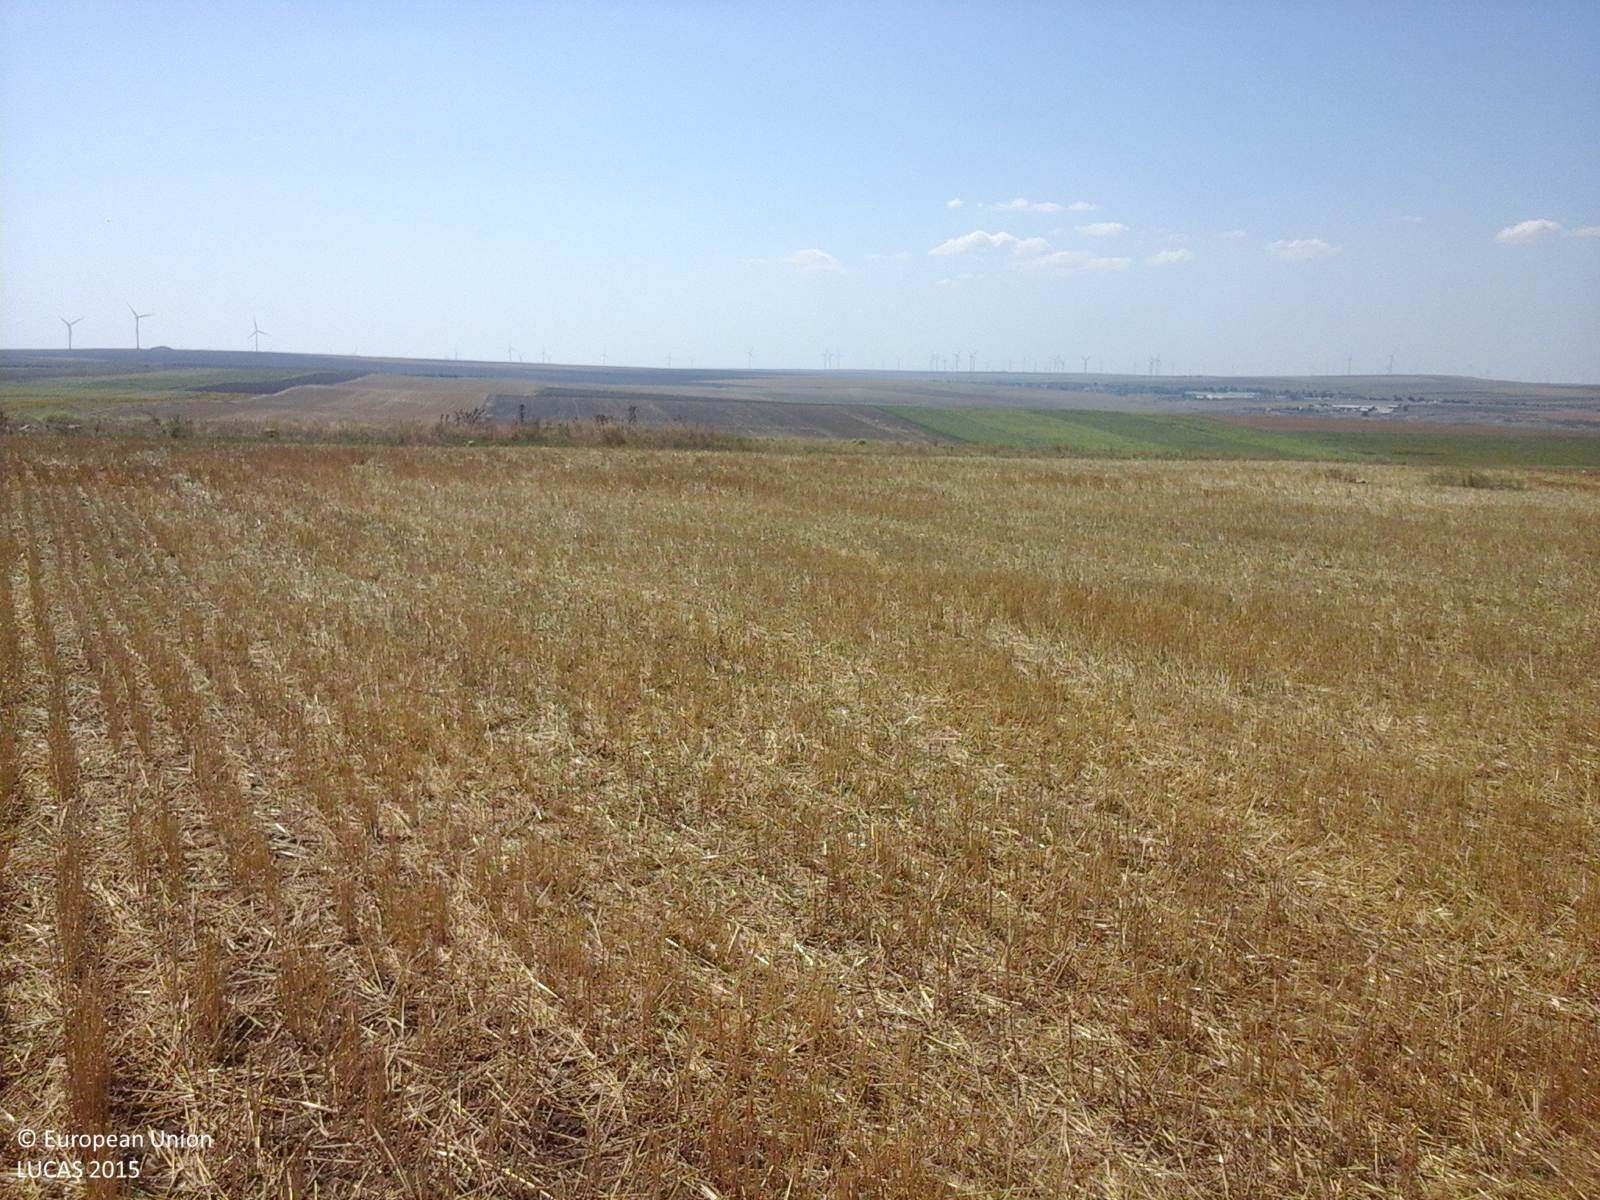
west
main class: Cropland
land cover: Common wheat
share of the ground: 10 - 25 %
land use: Agriculture (excluding fallow land and kitchen gardens)
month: August
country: RO
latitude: 44.4456
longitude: 28.4801
